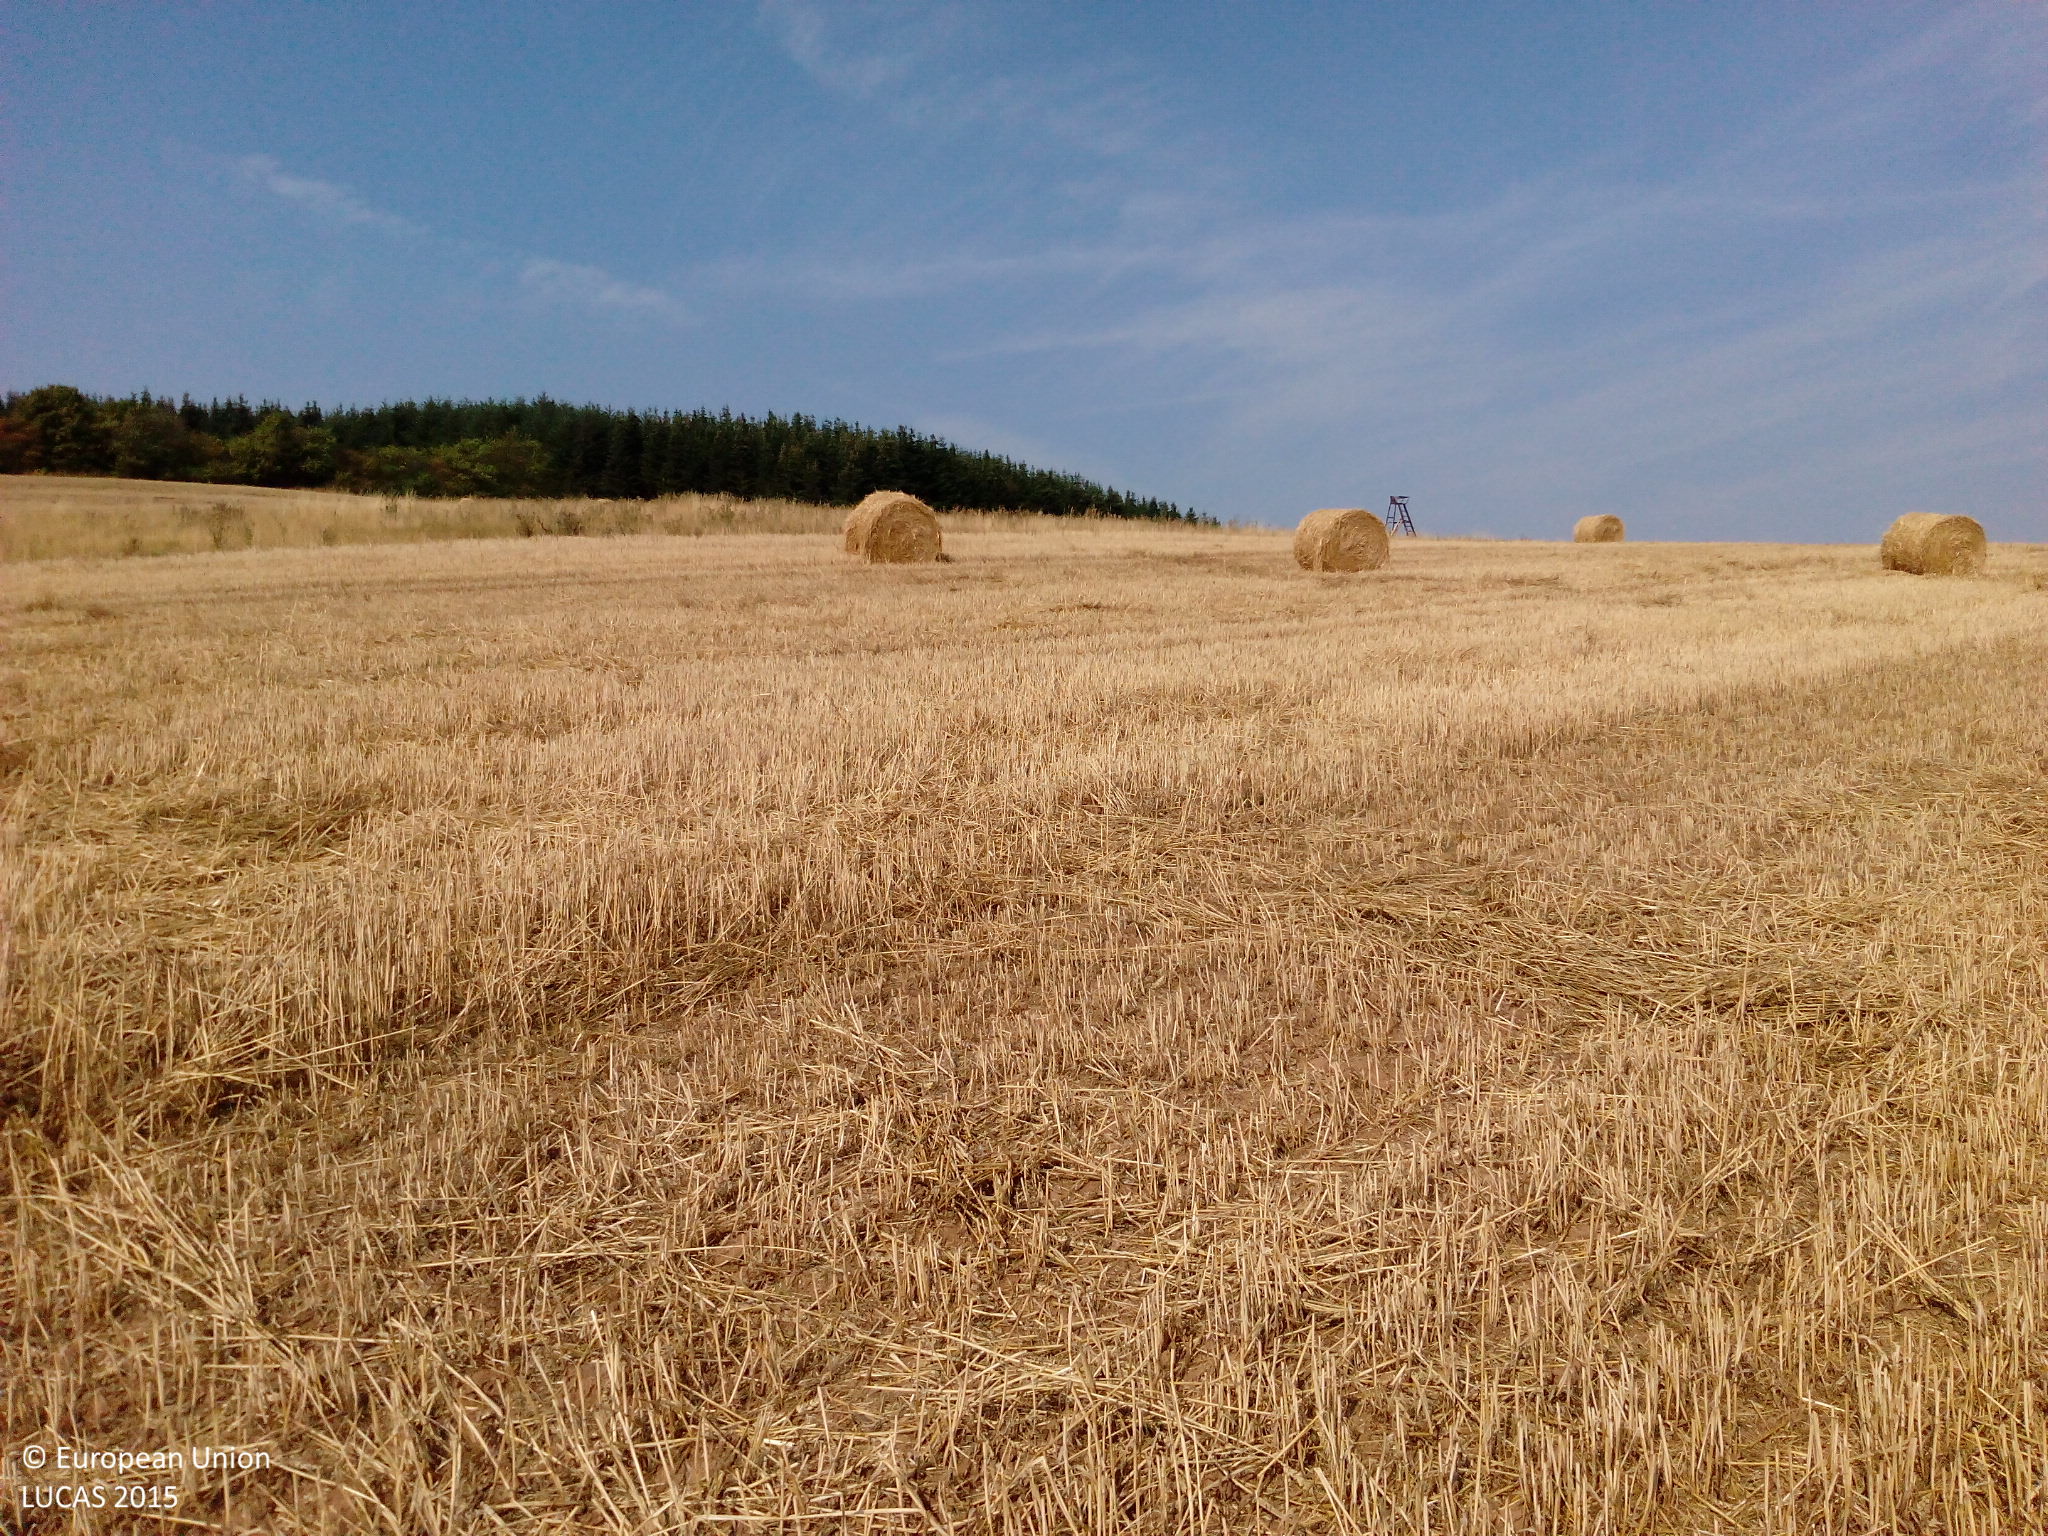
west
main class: Cropland
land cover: Common wheat
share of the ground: 10 - 25 %
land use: Agriculture (excluding fallow land and kitchen gardens)
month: August
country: DE
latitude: 49.7799
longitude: 7.5423
